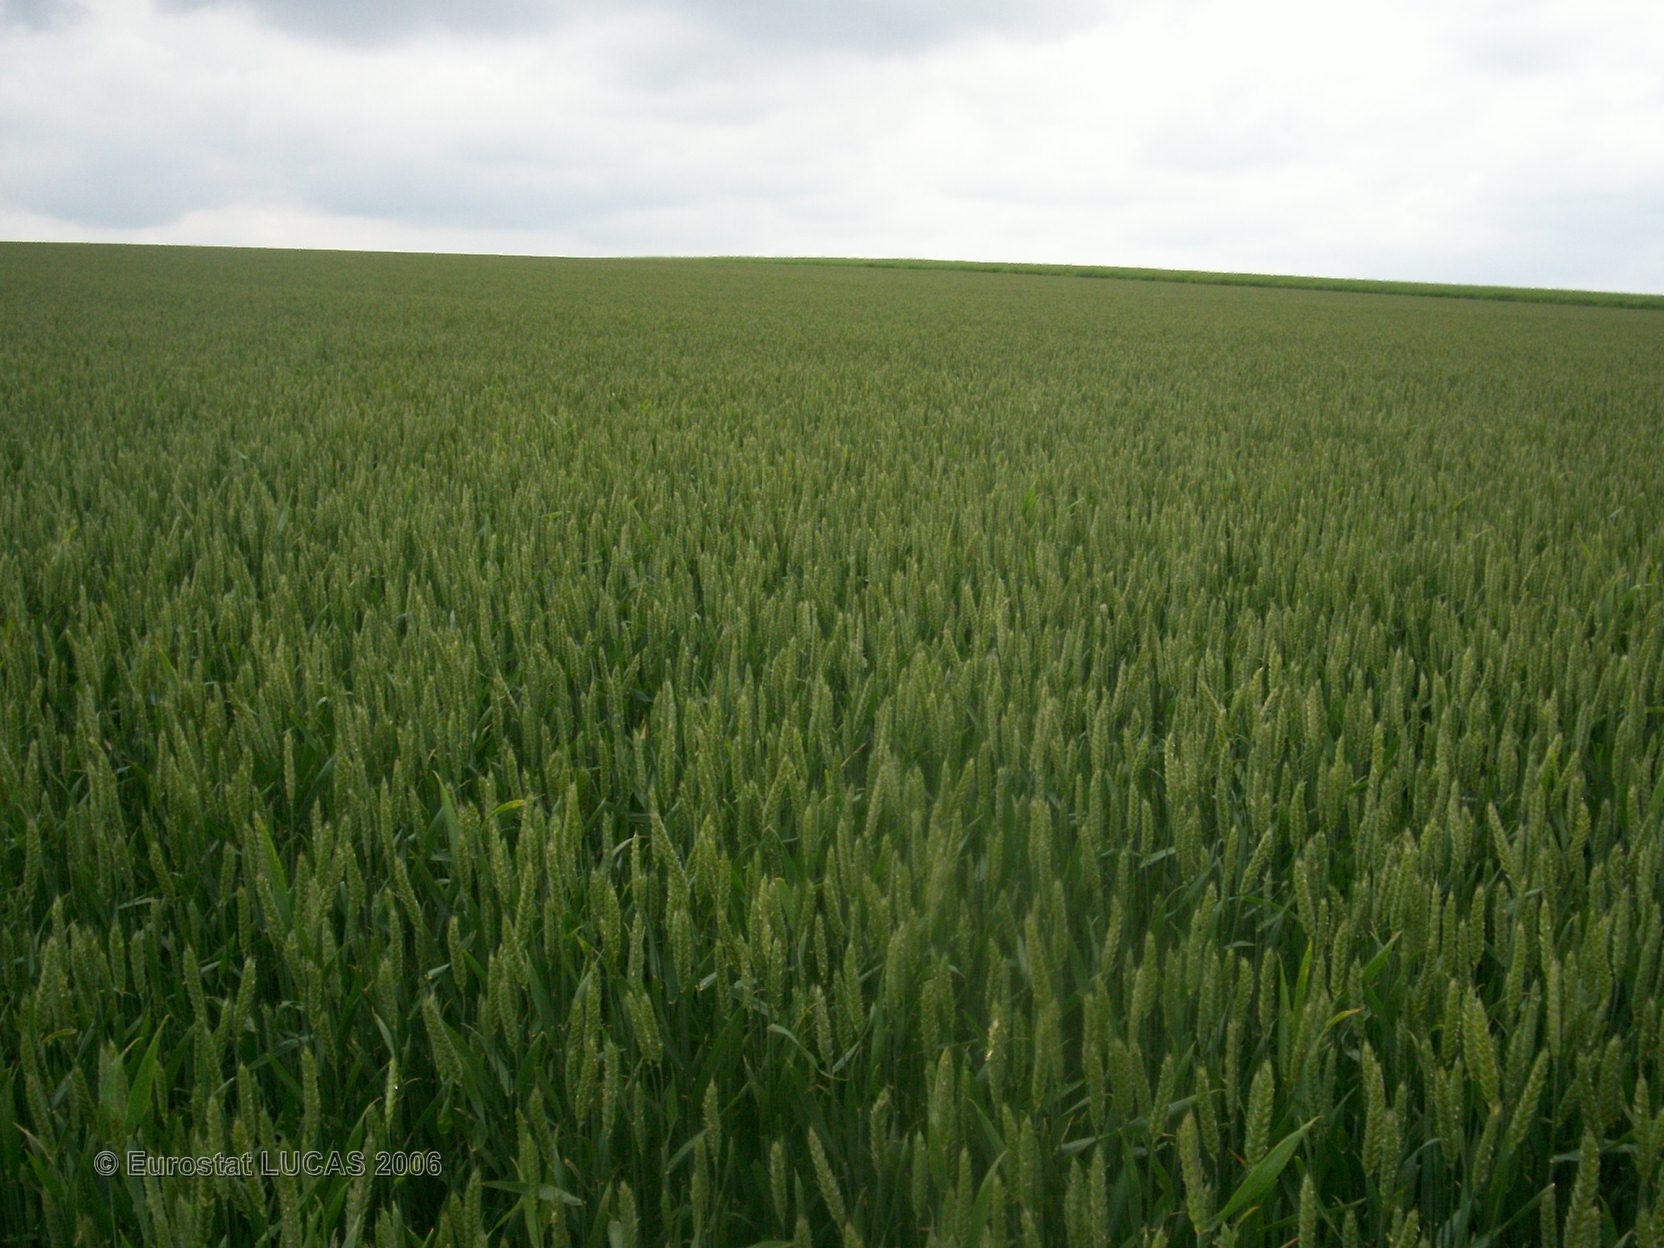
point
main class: Cropland
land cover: Common wheat
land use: Agriculture (excluding fallow land and kitchen gardens)
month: June
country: FR
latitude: 48.5875
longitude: 4.4250
